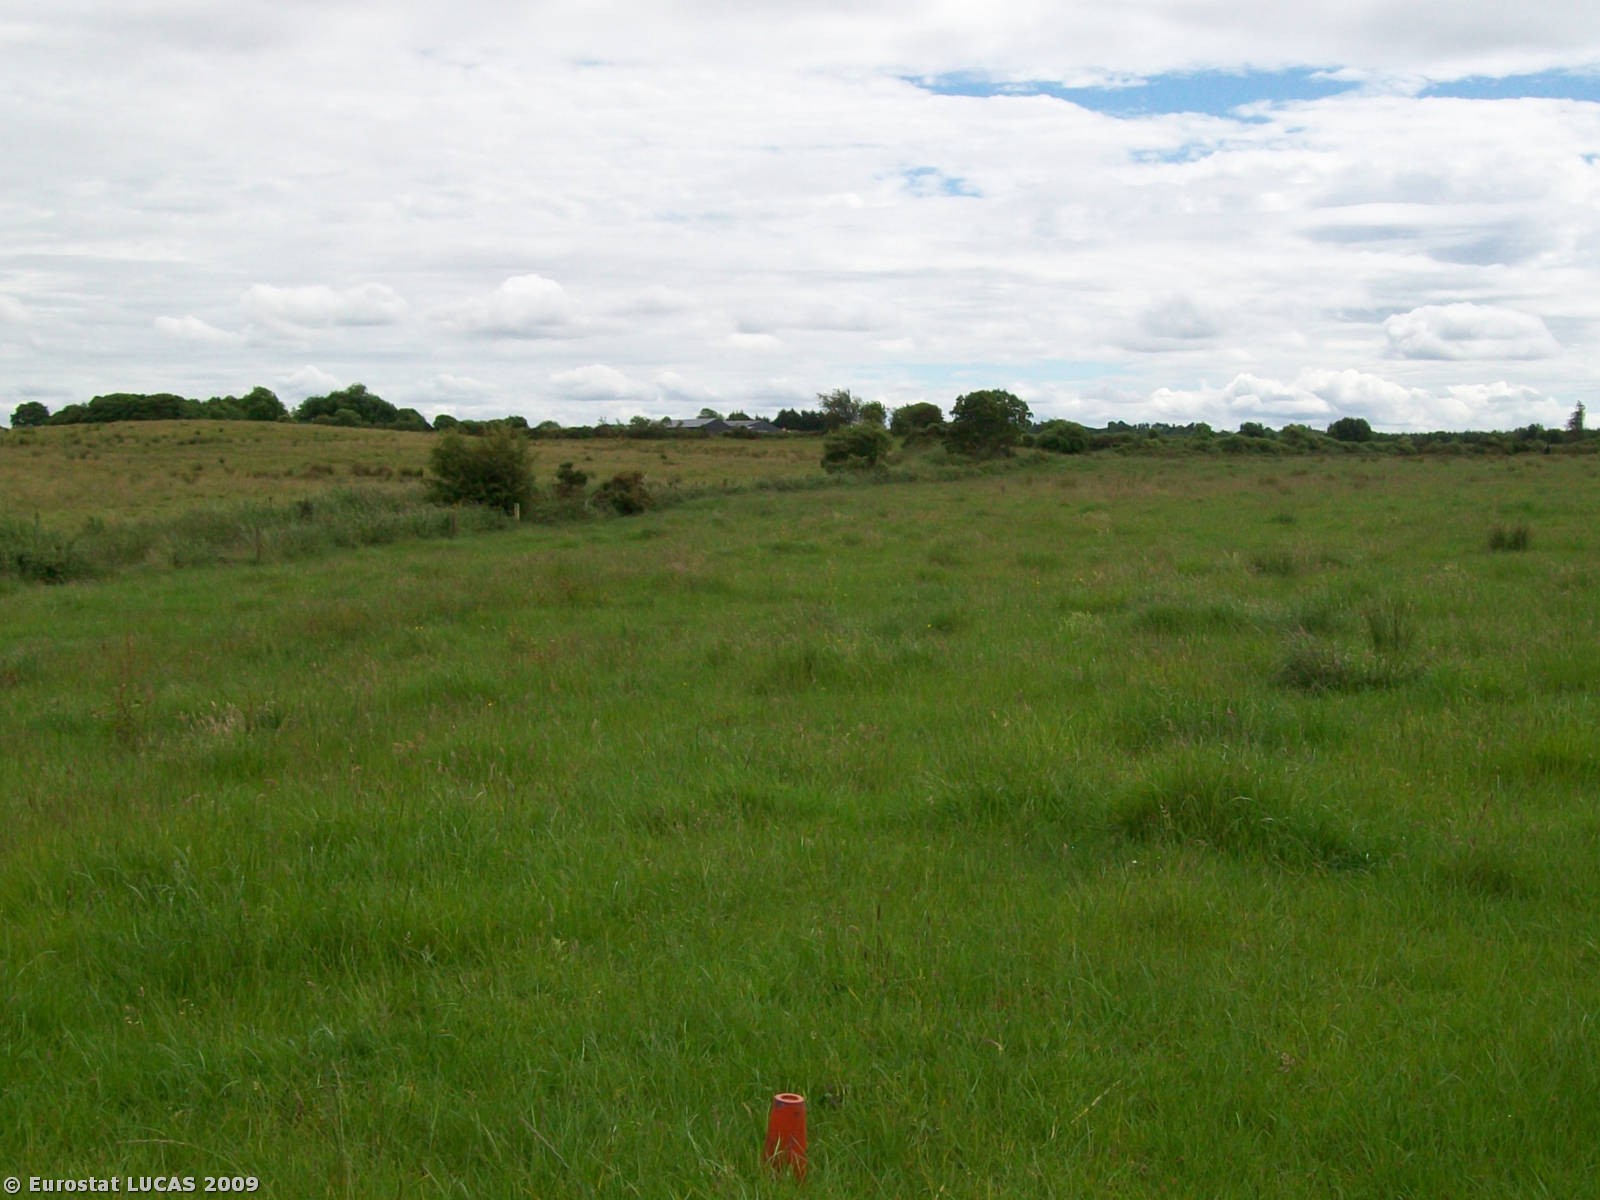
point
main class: Artificial land
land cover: Non built-up linear features
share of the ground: > 75 %
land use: Road transport
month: June
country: IE
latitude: 53.8027
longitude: -8.9942
